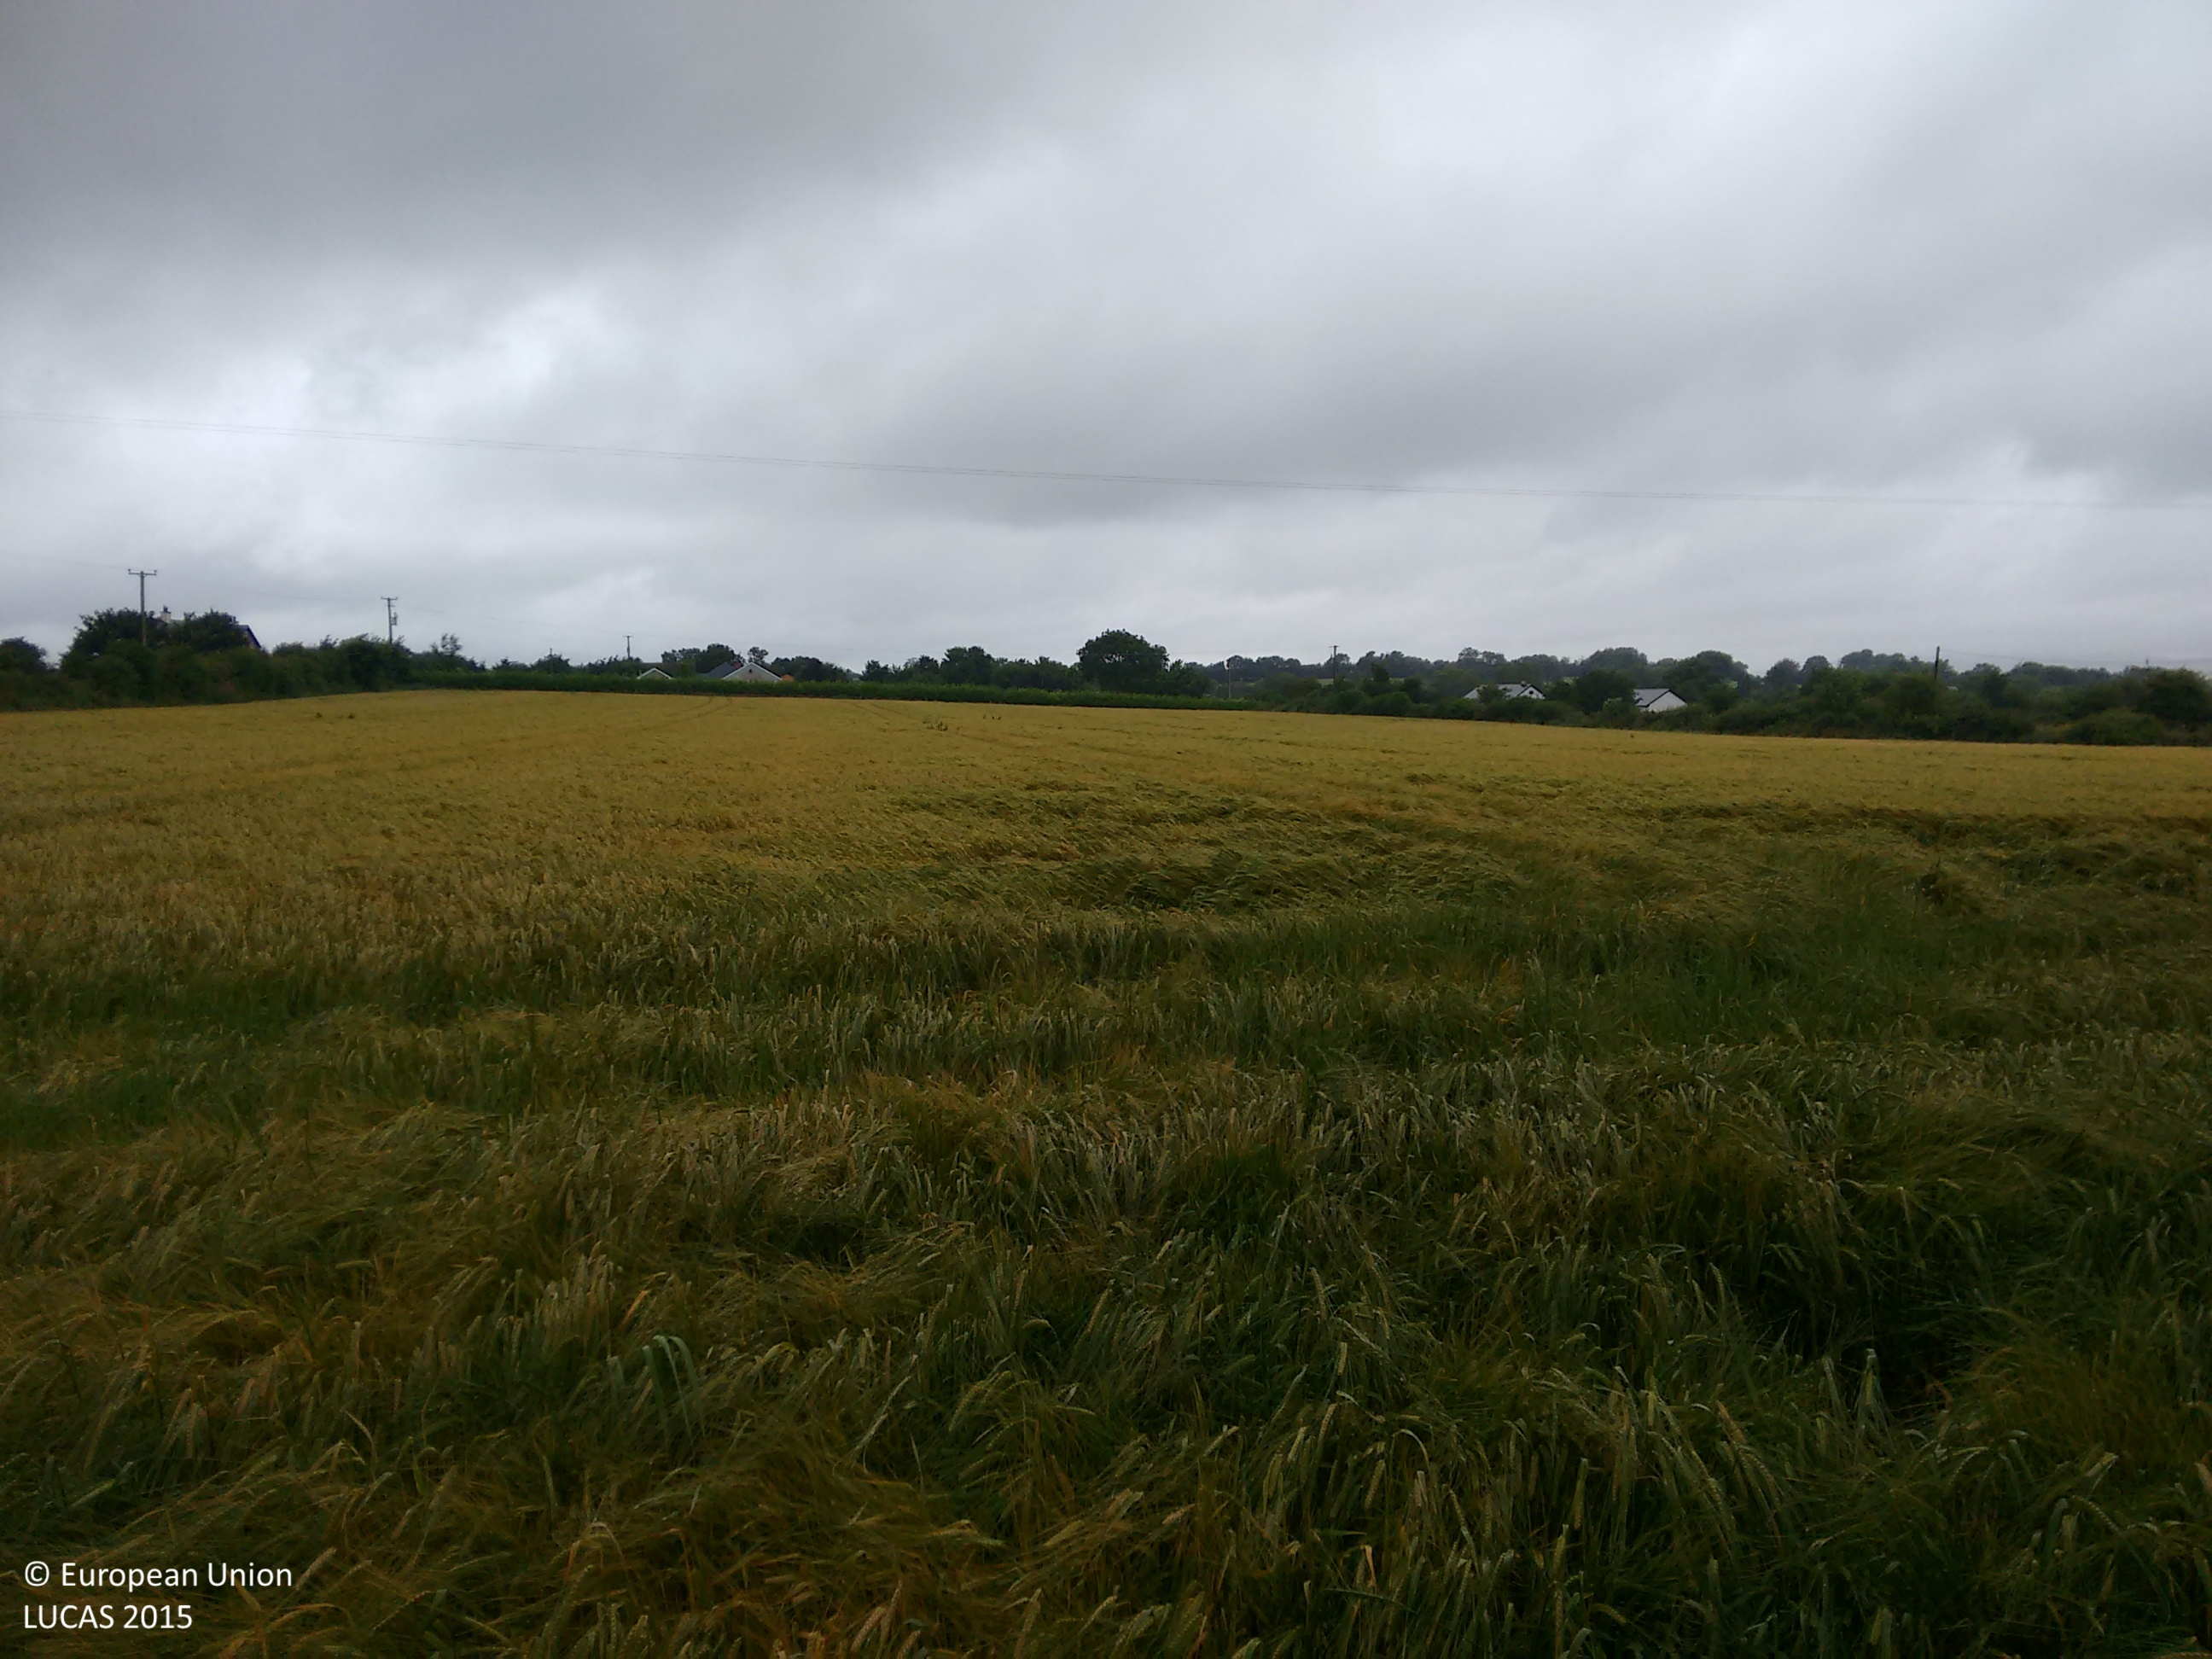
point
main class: Cropland
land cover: Barley
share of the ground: > 75 %
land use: Agriculture (excluding fallow land and kitchen gardens)
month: August
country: IE
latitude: 52.7064
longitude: -6.4509
